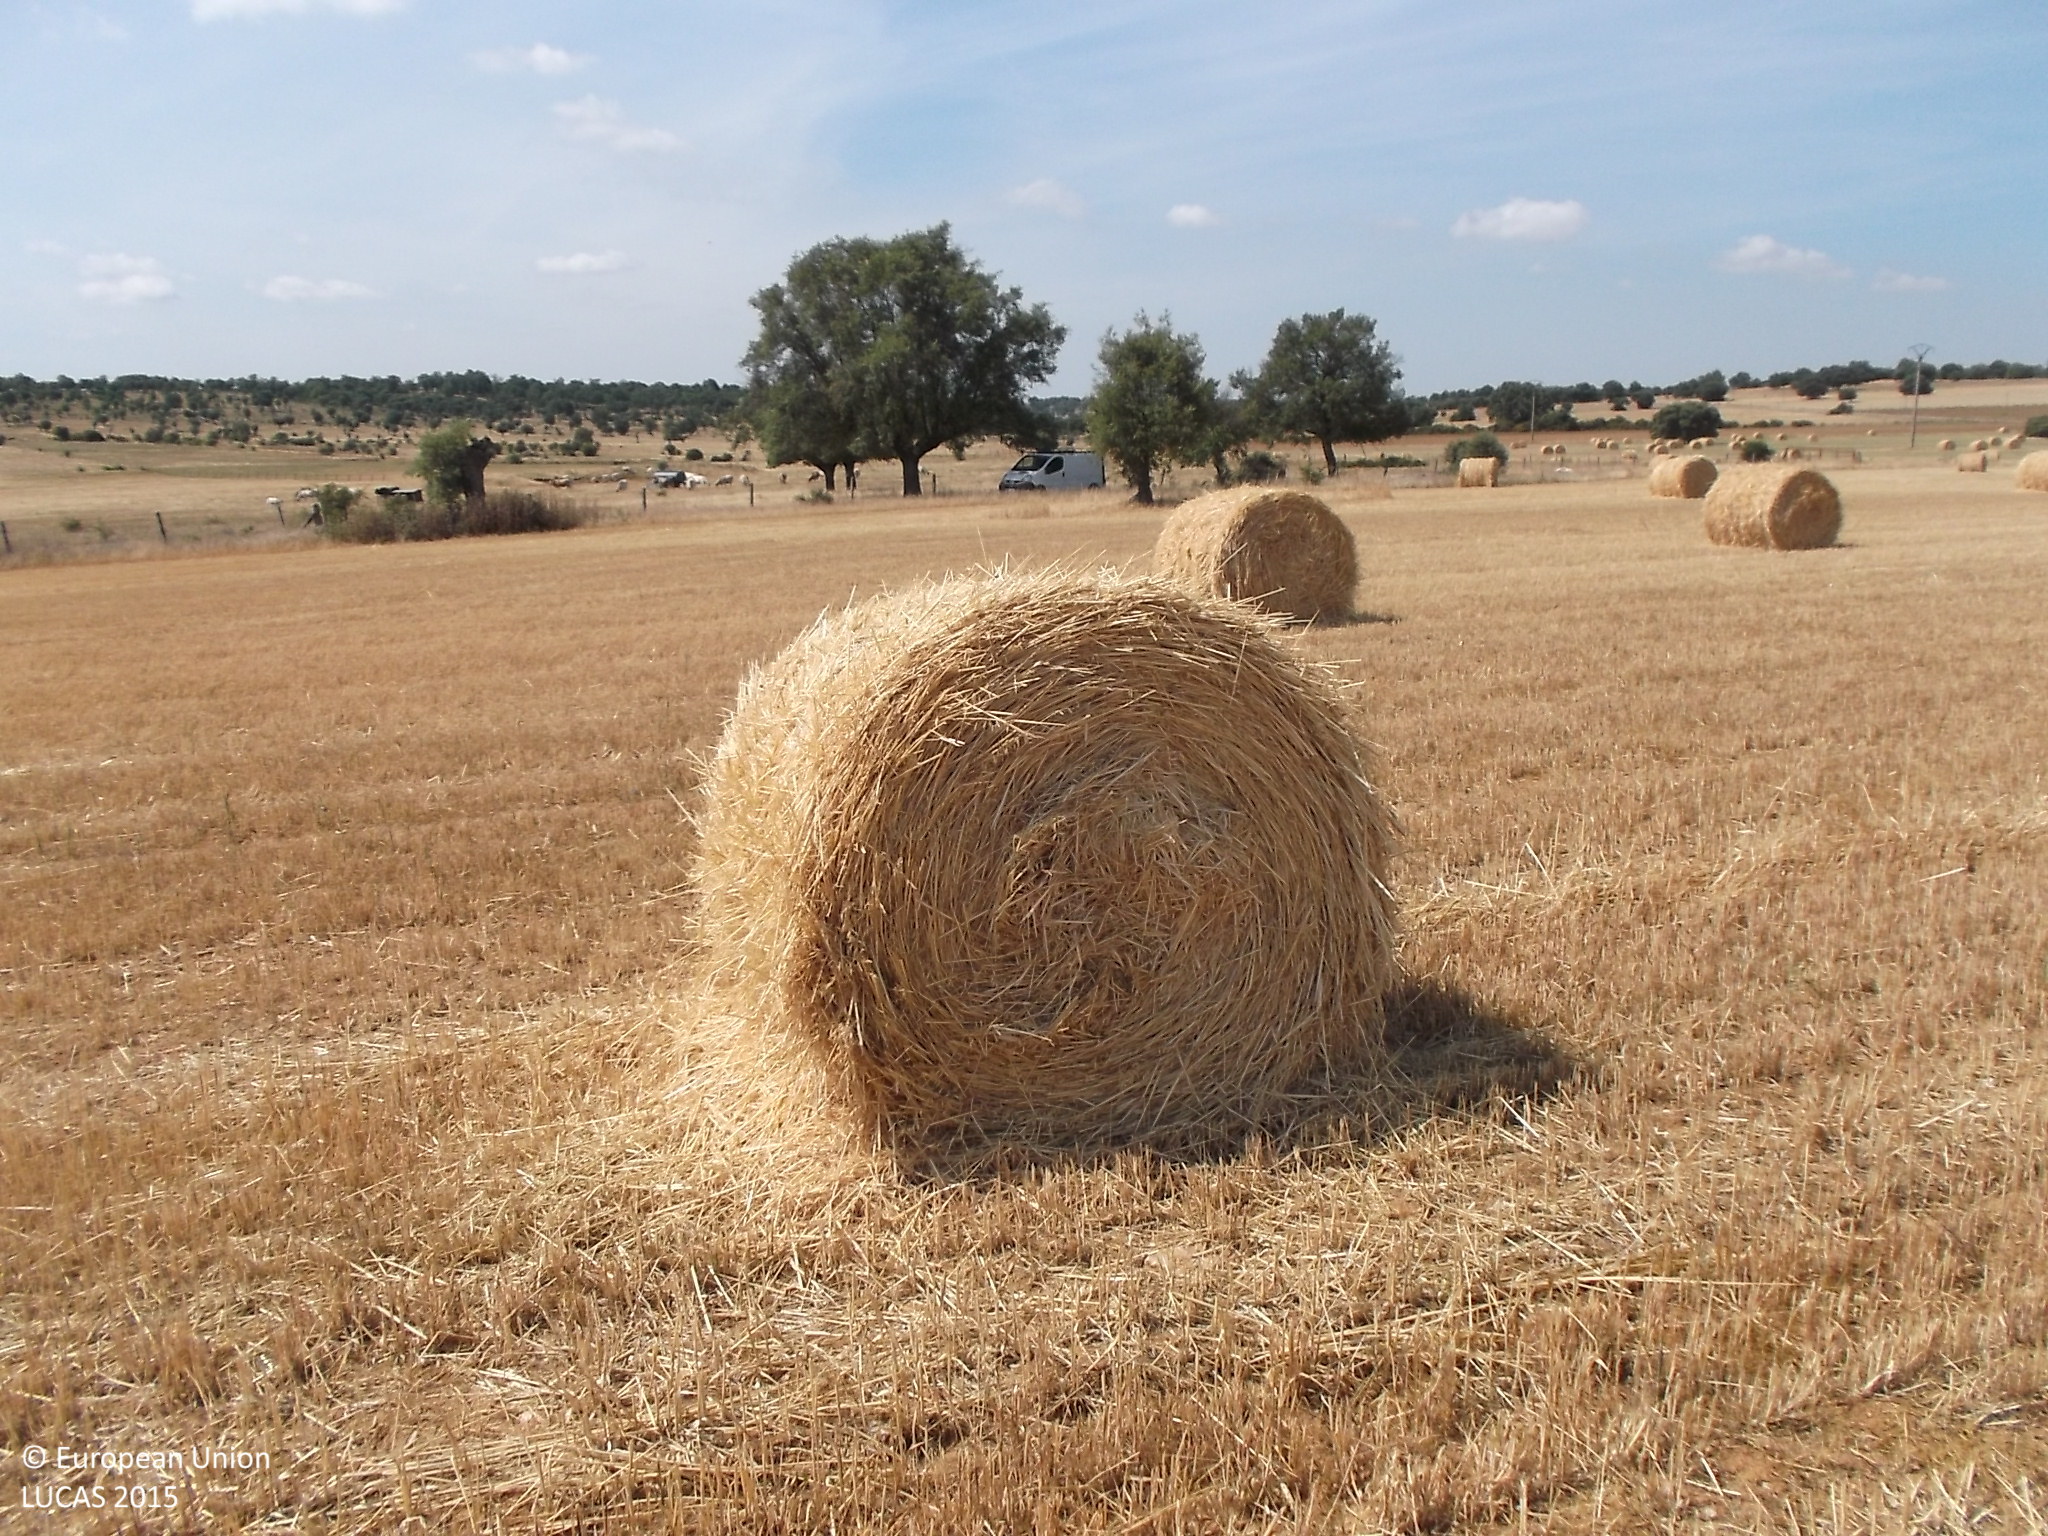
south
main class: Cropland
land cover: Mixed cereals for fodder
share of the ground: < 10 %
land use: Agriculture (excluding fallow land and kitchen gardens)
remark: Harvested field
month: June
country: ES
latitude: 41.2095
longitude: -5.9850
